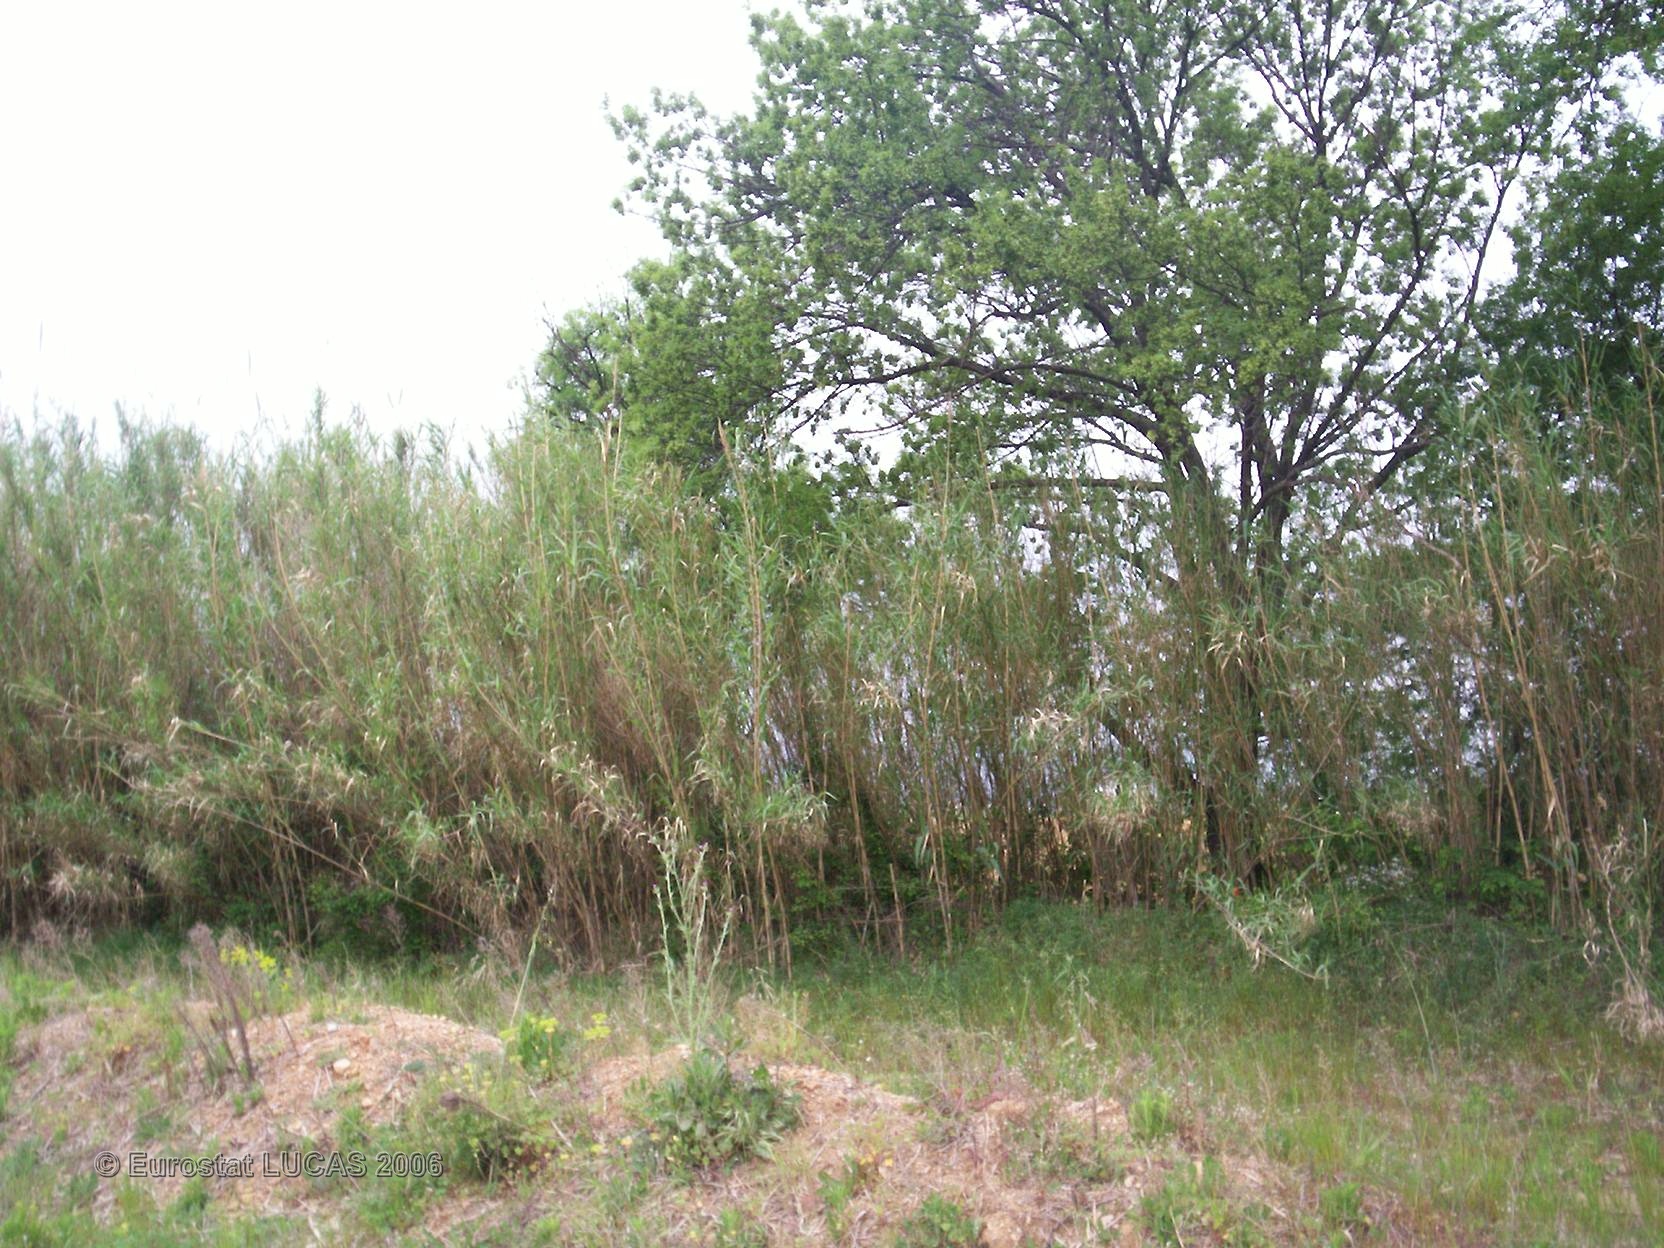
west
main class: Grassland
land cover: Grassland without tree/shrub cover
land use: Agriculture (excluding fallow land and kitchen gardens)
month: May
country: FR
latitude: 43.6565
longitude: 3.4739
